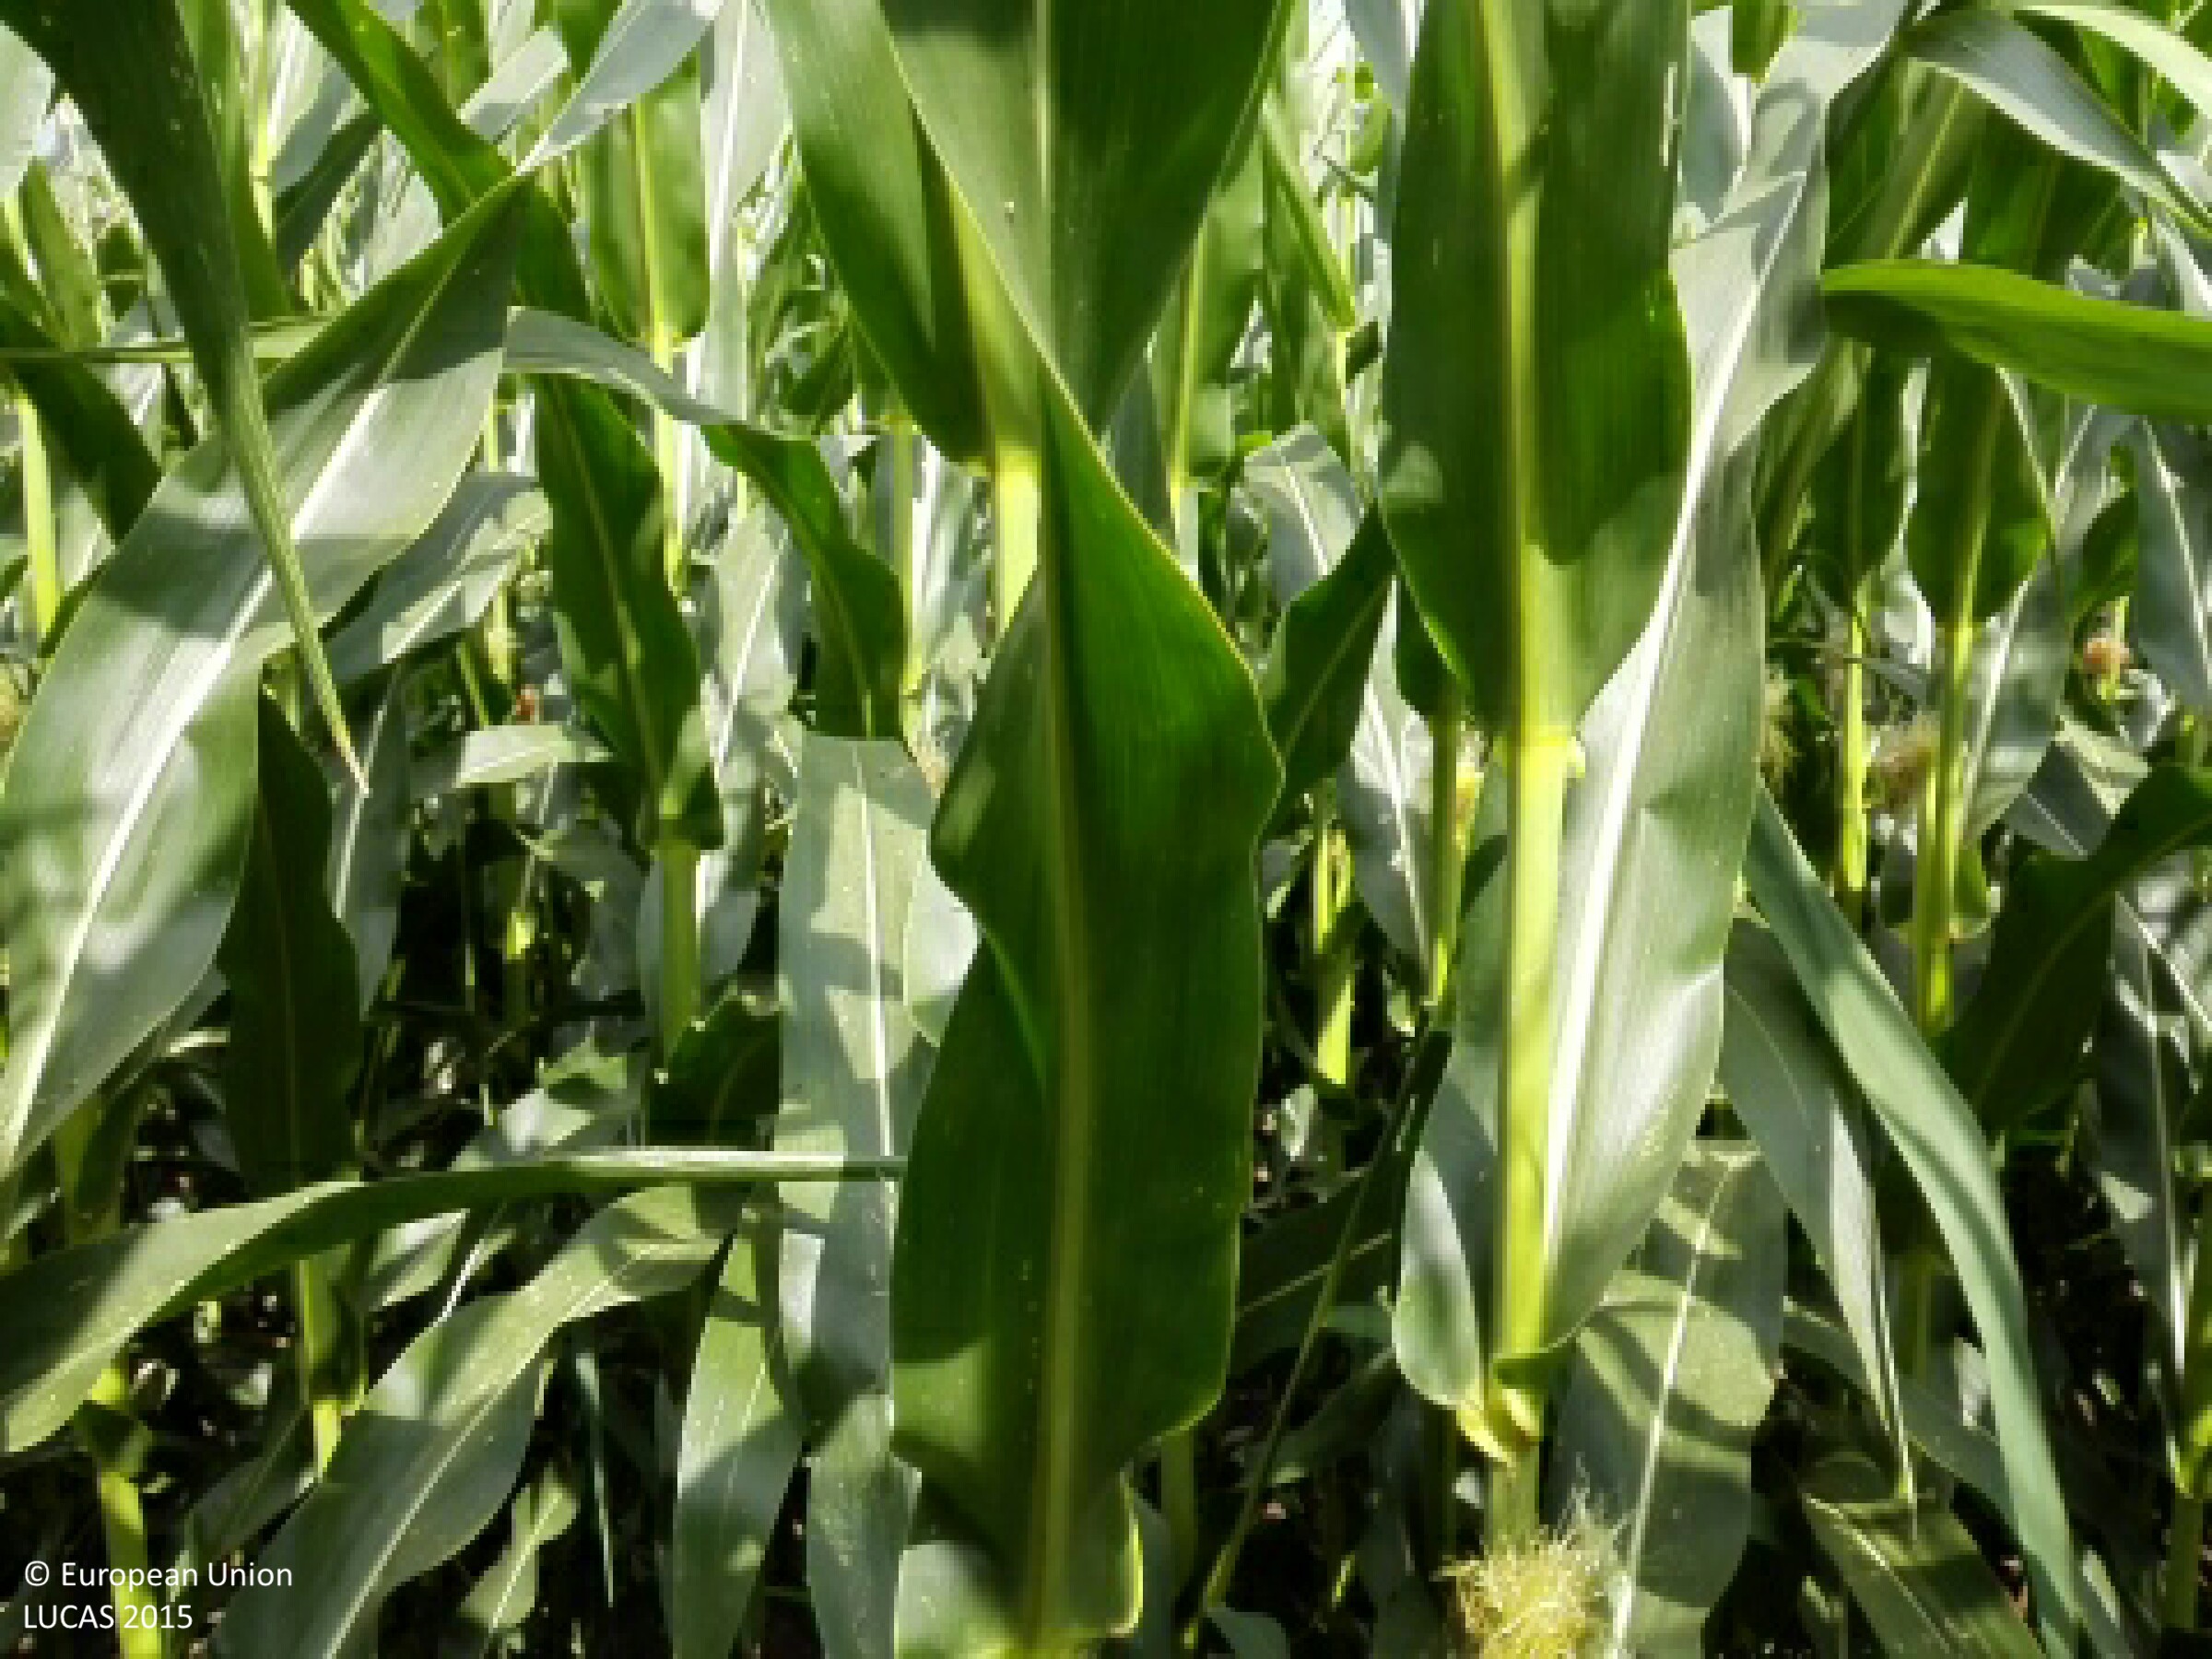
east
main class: Cropland
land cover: Maize
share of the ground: > 75 %
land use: Agriculture (excluding fallow land and kitchen gardens)
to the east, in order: Maize
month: July
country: HU
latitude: 47.5446
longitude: 21.3479
